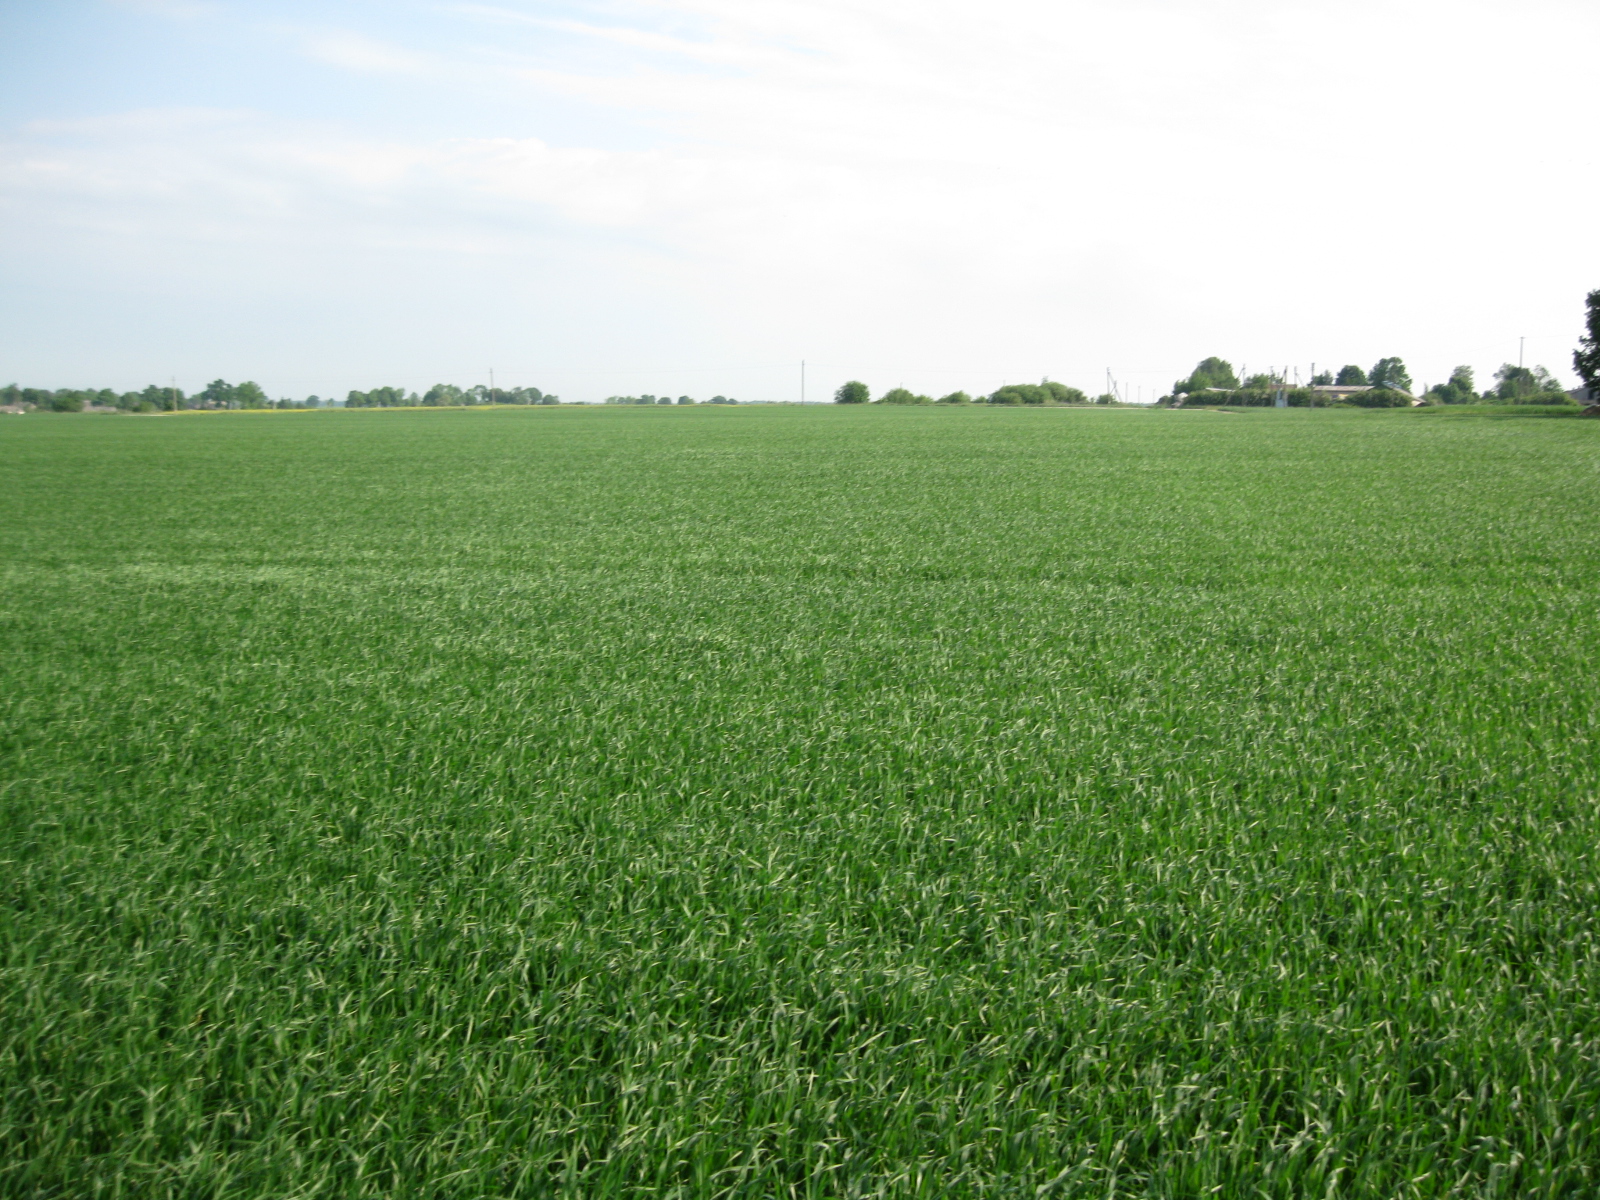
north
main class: Cropland
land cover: Common wheat
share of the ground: > 75 %
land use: Agriculture (excluding fallow land and kitchen gardens)
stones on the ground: < 10 %
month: June
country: LT
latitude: 55.7966
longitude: 23.6878
